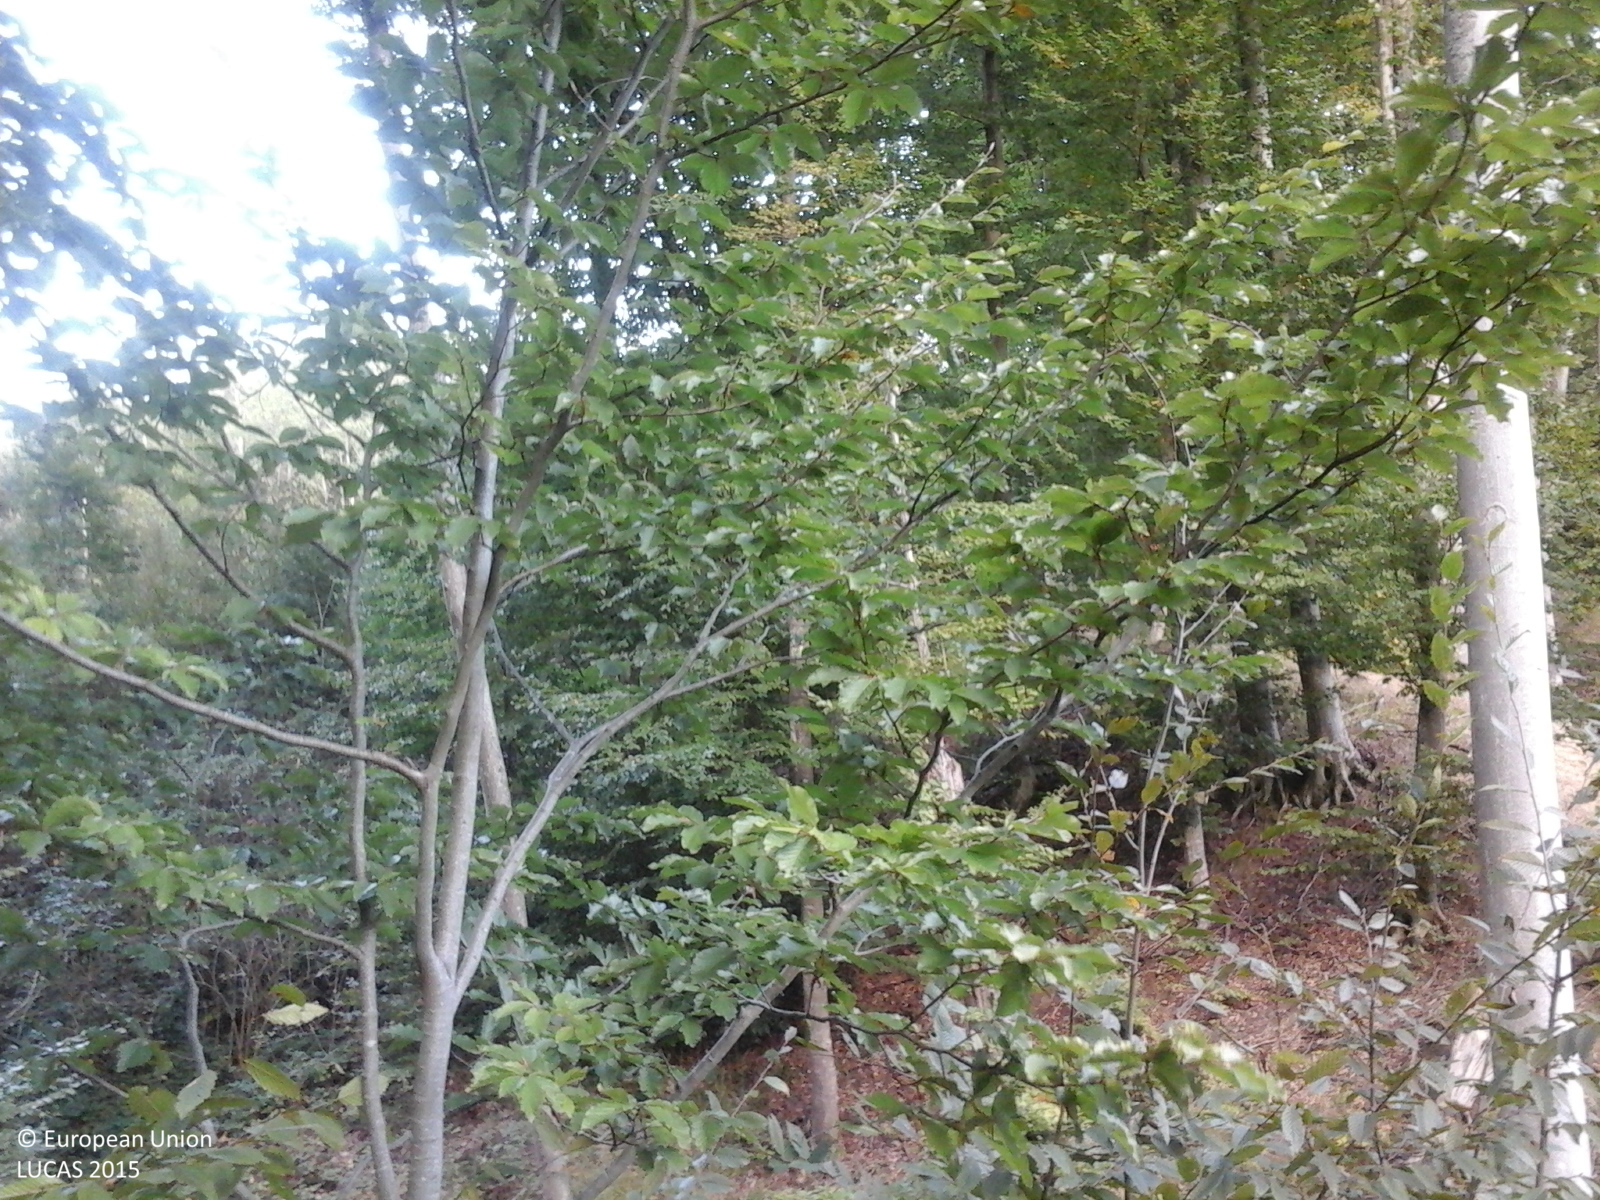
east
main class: Woodland
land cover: Broadleaved woodland
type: acidophilous oak and oak-birch forest
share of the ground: > 75 %
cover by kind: broadleaved forest trees 100 %
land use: Forestry
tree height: > 5 m
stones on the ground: < 10 %
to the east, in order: Broadleaved woodland
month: September
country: RO
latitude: 45.7185
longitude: 22.0789
